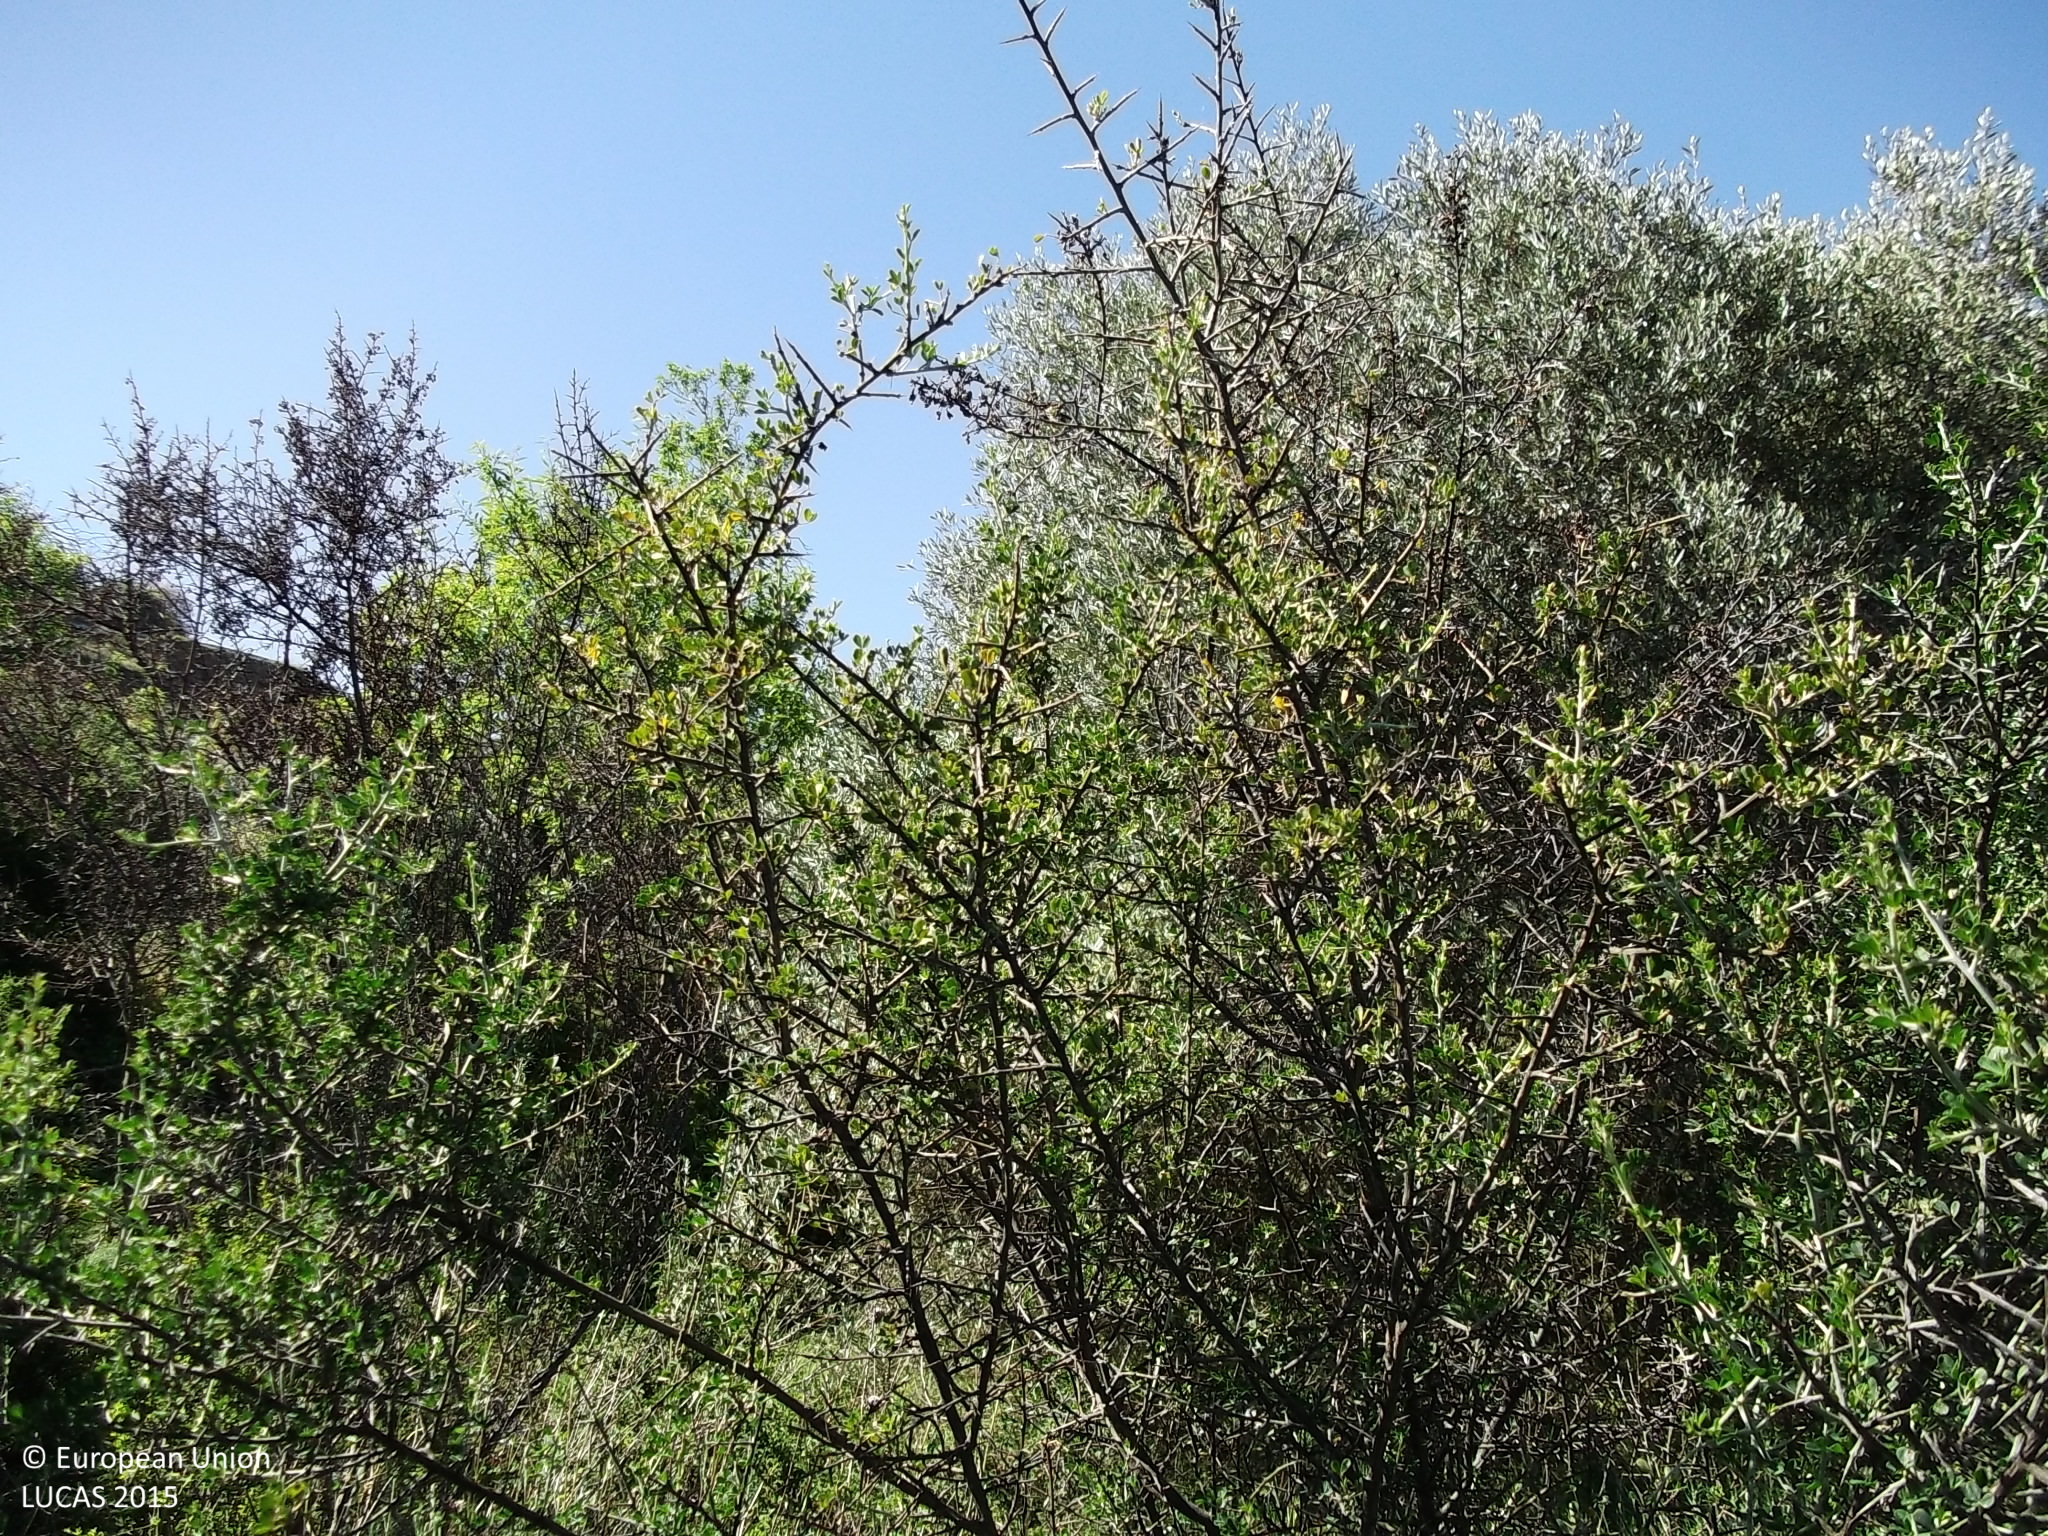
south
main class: Shrubland
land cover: Shrubland with sparse tree cover
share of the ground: > 75 %
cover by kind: shrubs 95 %, broadleaved forest trees 5 %
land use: Semi-natural and natural areas not in use
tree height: < 5 m
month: April
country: CY
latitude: 34.8259
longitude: 33.1681
